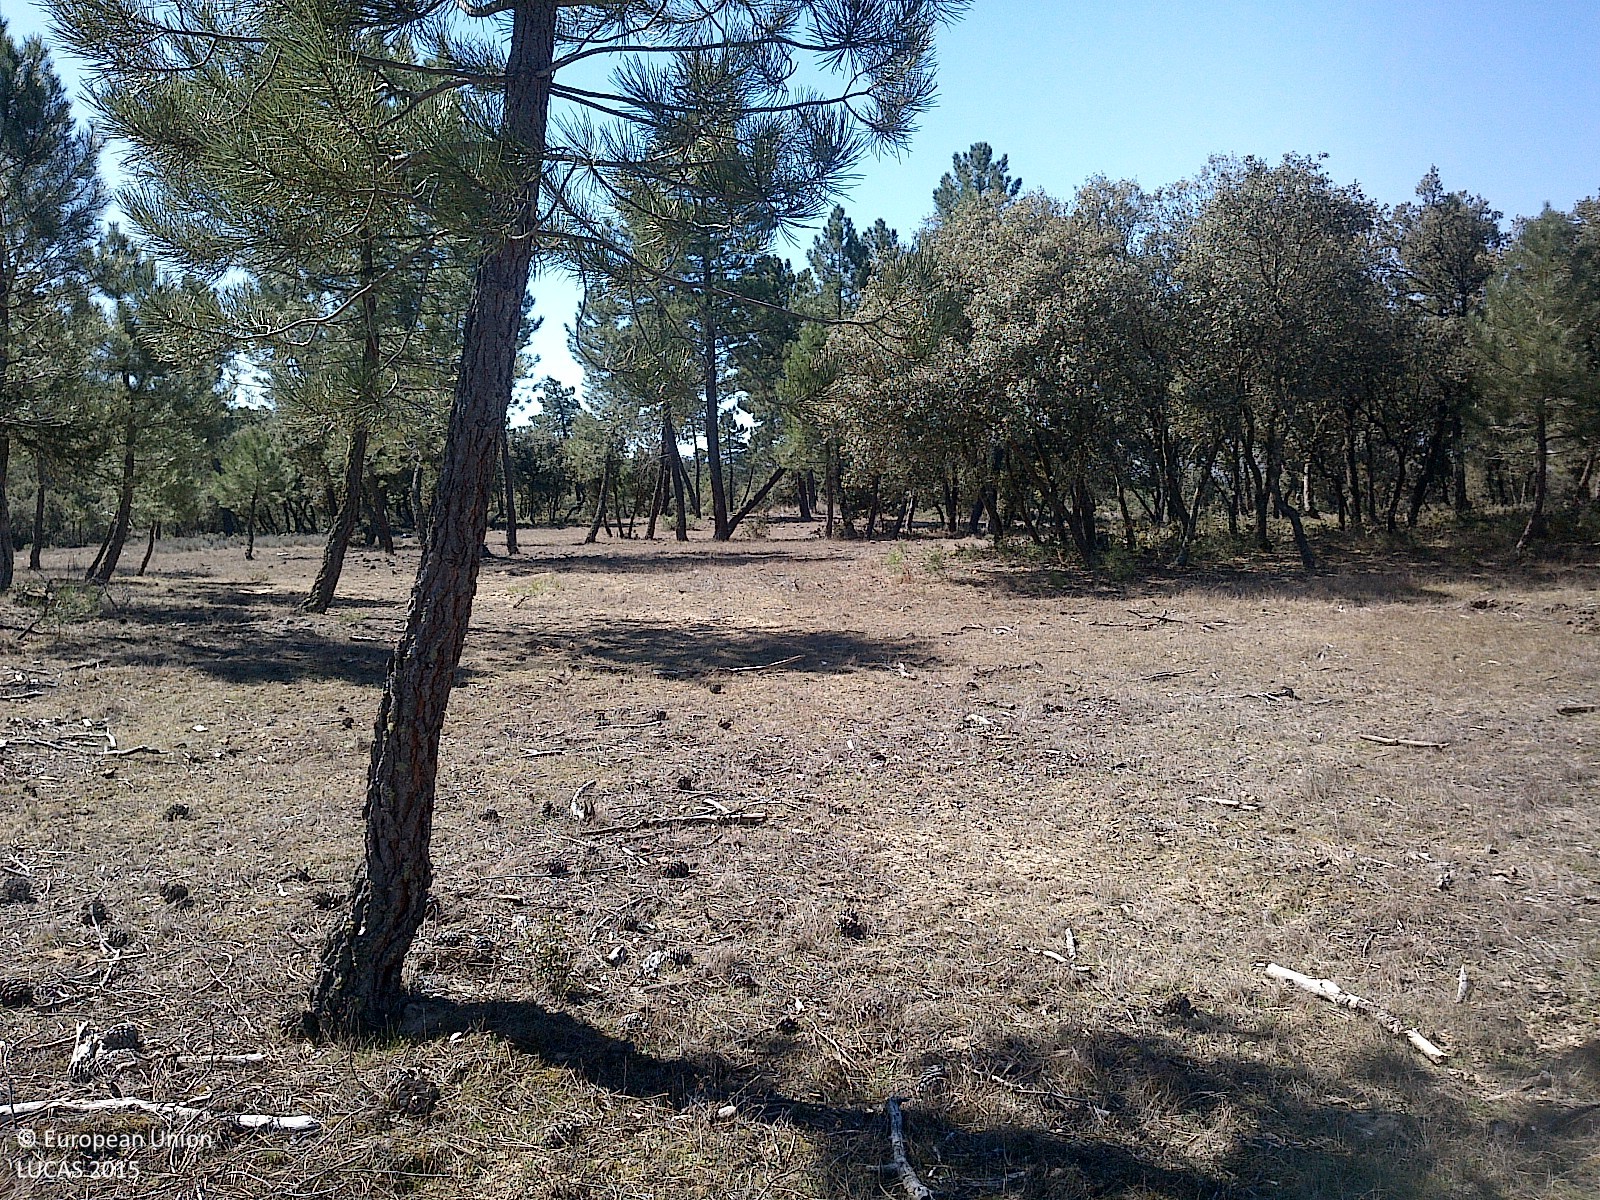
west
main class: Woodland
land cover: Pine dominated coniferous woodland
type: coniferous forest of the mediterranean region
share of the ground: 10 - 25 %
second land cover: Spontaneously vegetated surfaces
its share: > 75 %
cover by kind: herbaceous plants 65 %, coniferous forest trees 25 %, broadleaved forest trees 5 %, consolidated bare surface 5 %
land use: Forestry
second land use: Agriculture (excluding fallow land and kitchen gardens)
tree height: > 5 m
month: April
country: ES
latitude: 41.6640
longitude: -3.5619
